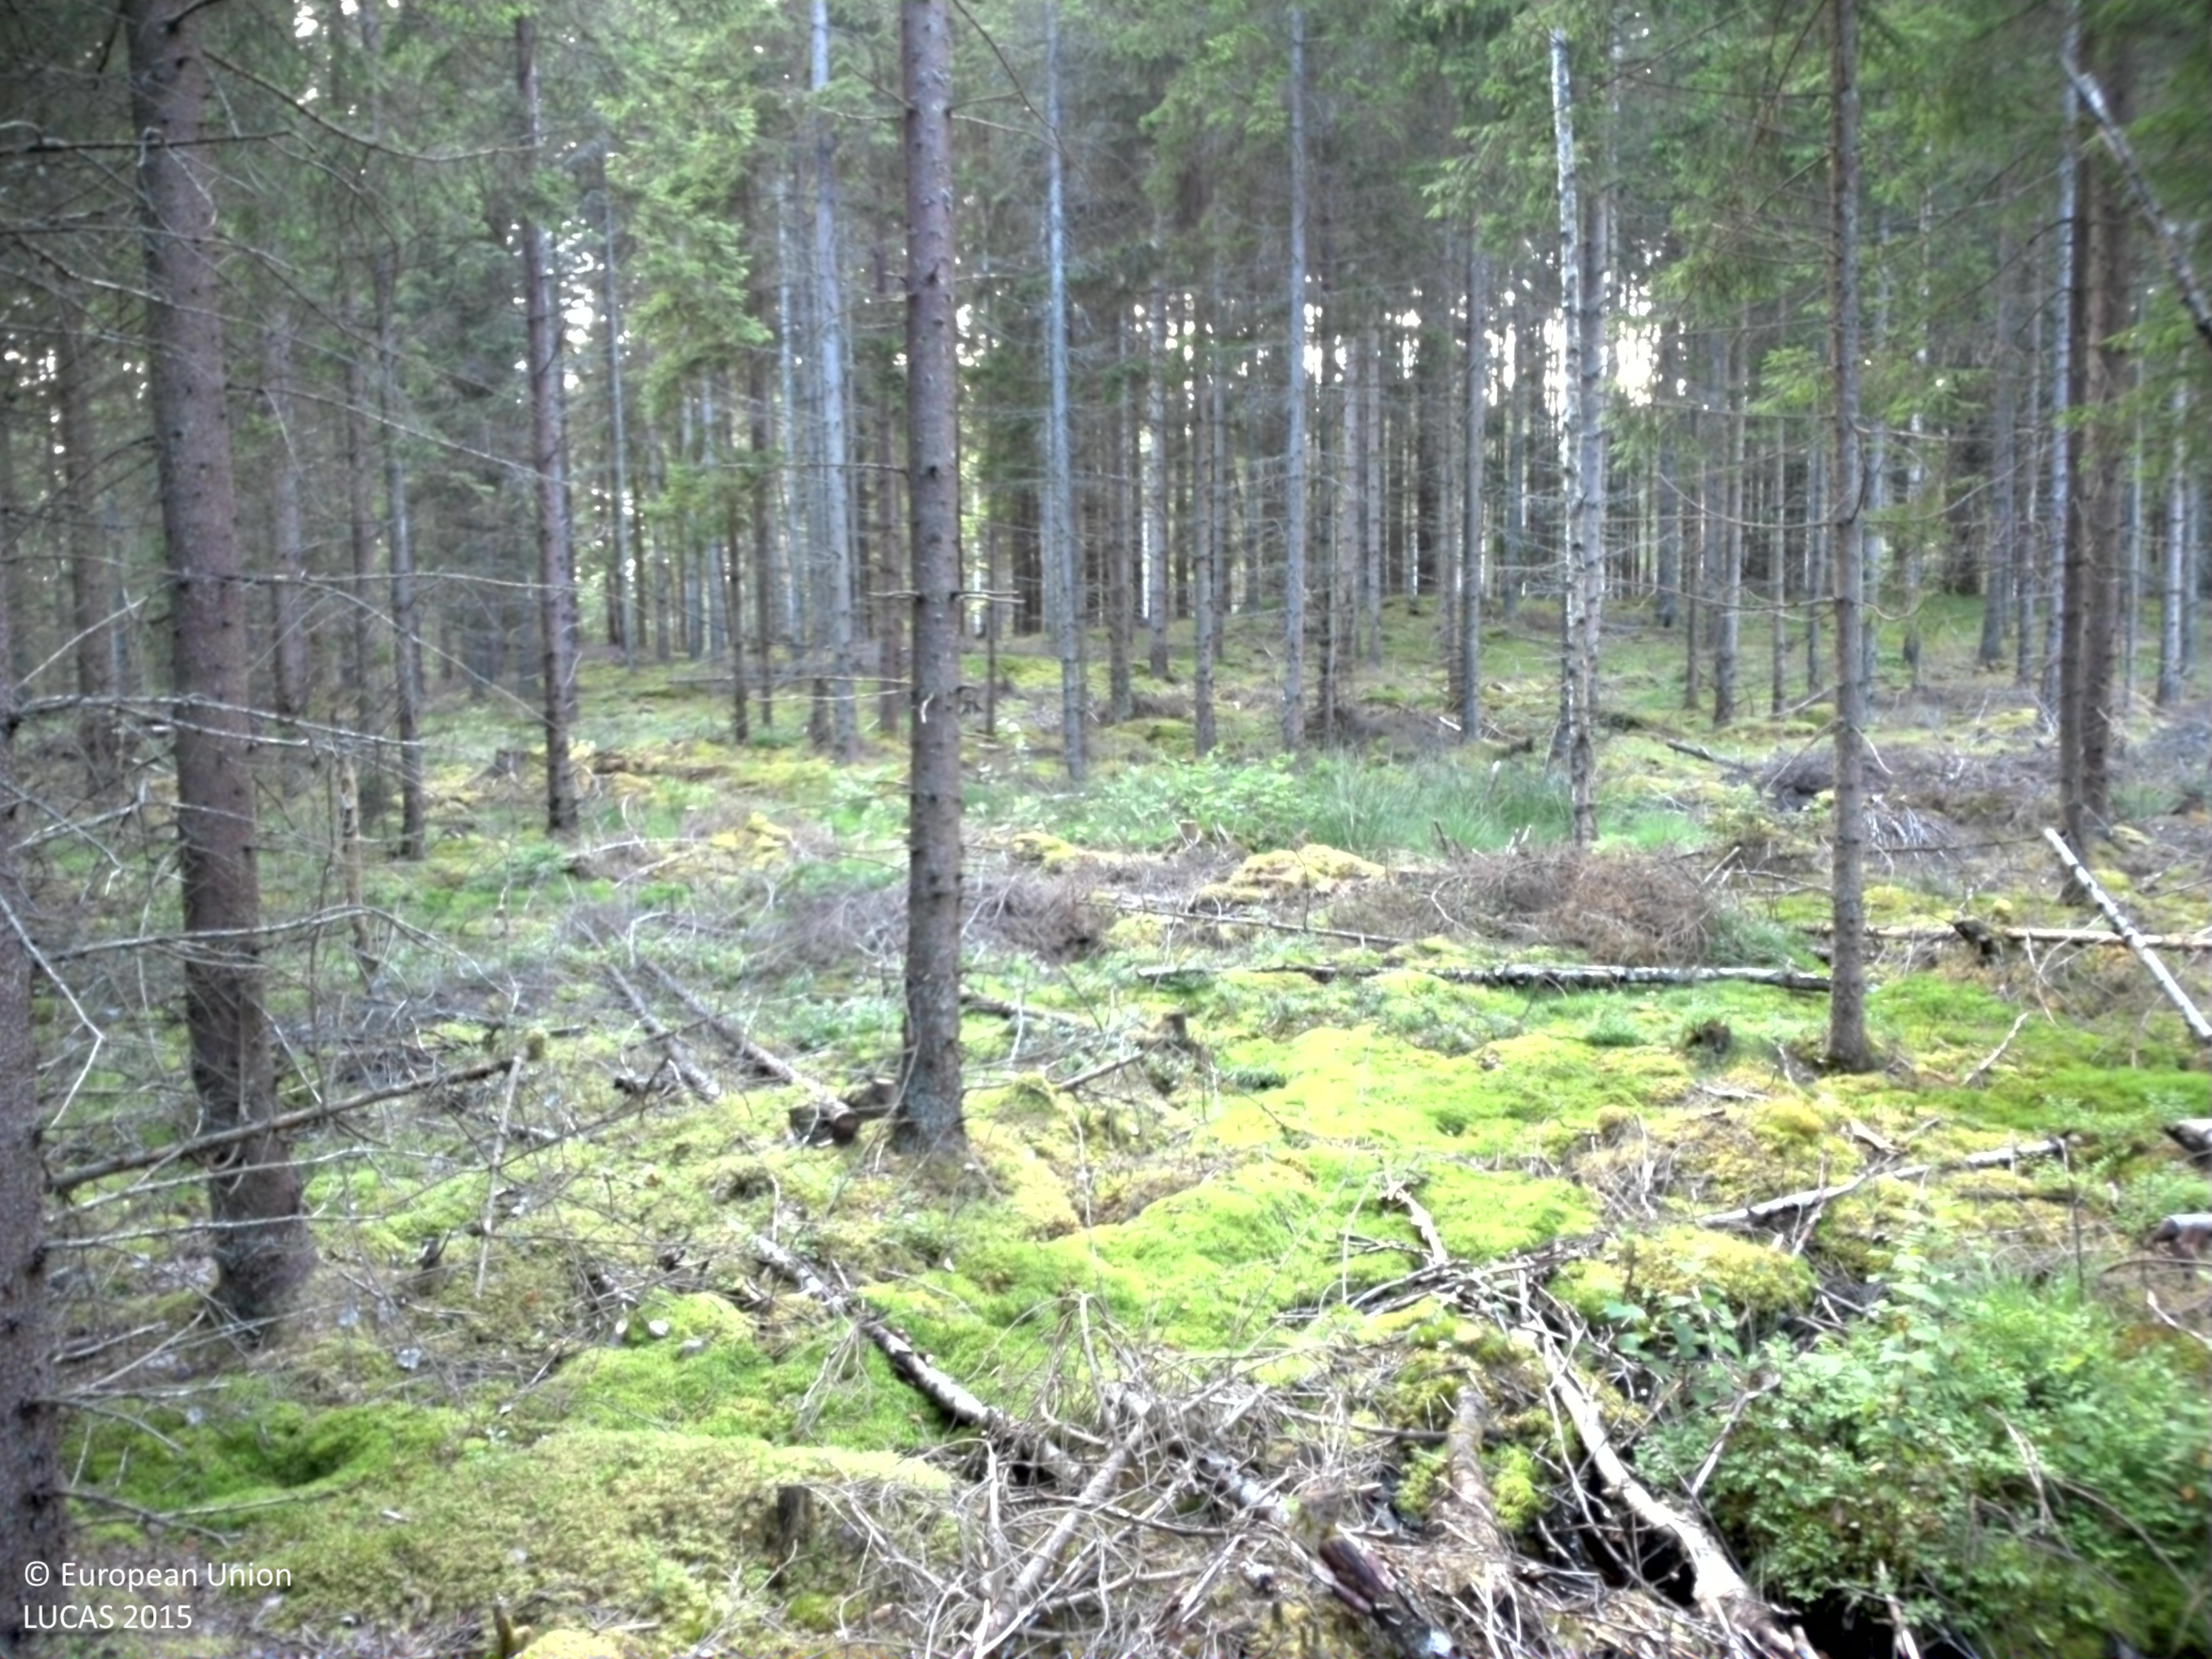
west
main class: Woodland
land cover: Spruce dominated coniferous woodland
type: boreal forest
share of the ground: 25 - 50 %
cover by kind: coniferous forest trees 45 %, lichens and mosses 35 %, broadleaved forest trees 10 %, herbaceous plants 10 %
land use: Forestry
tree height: > 5 m
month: July
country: SE
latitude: 56.3907
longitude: 14.6793
